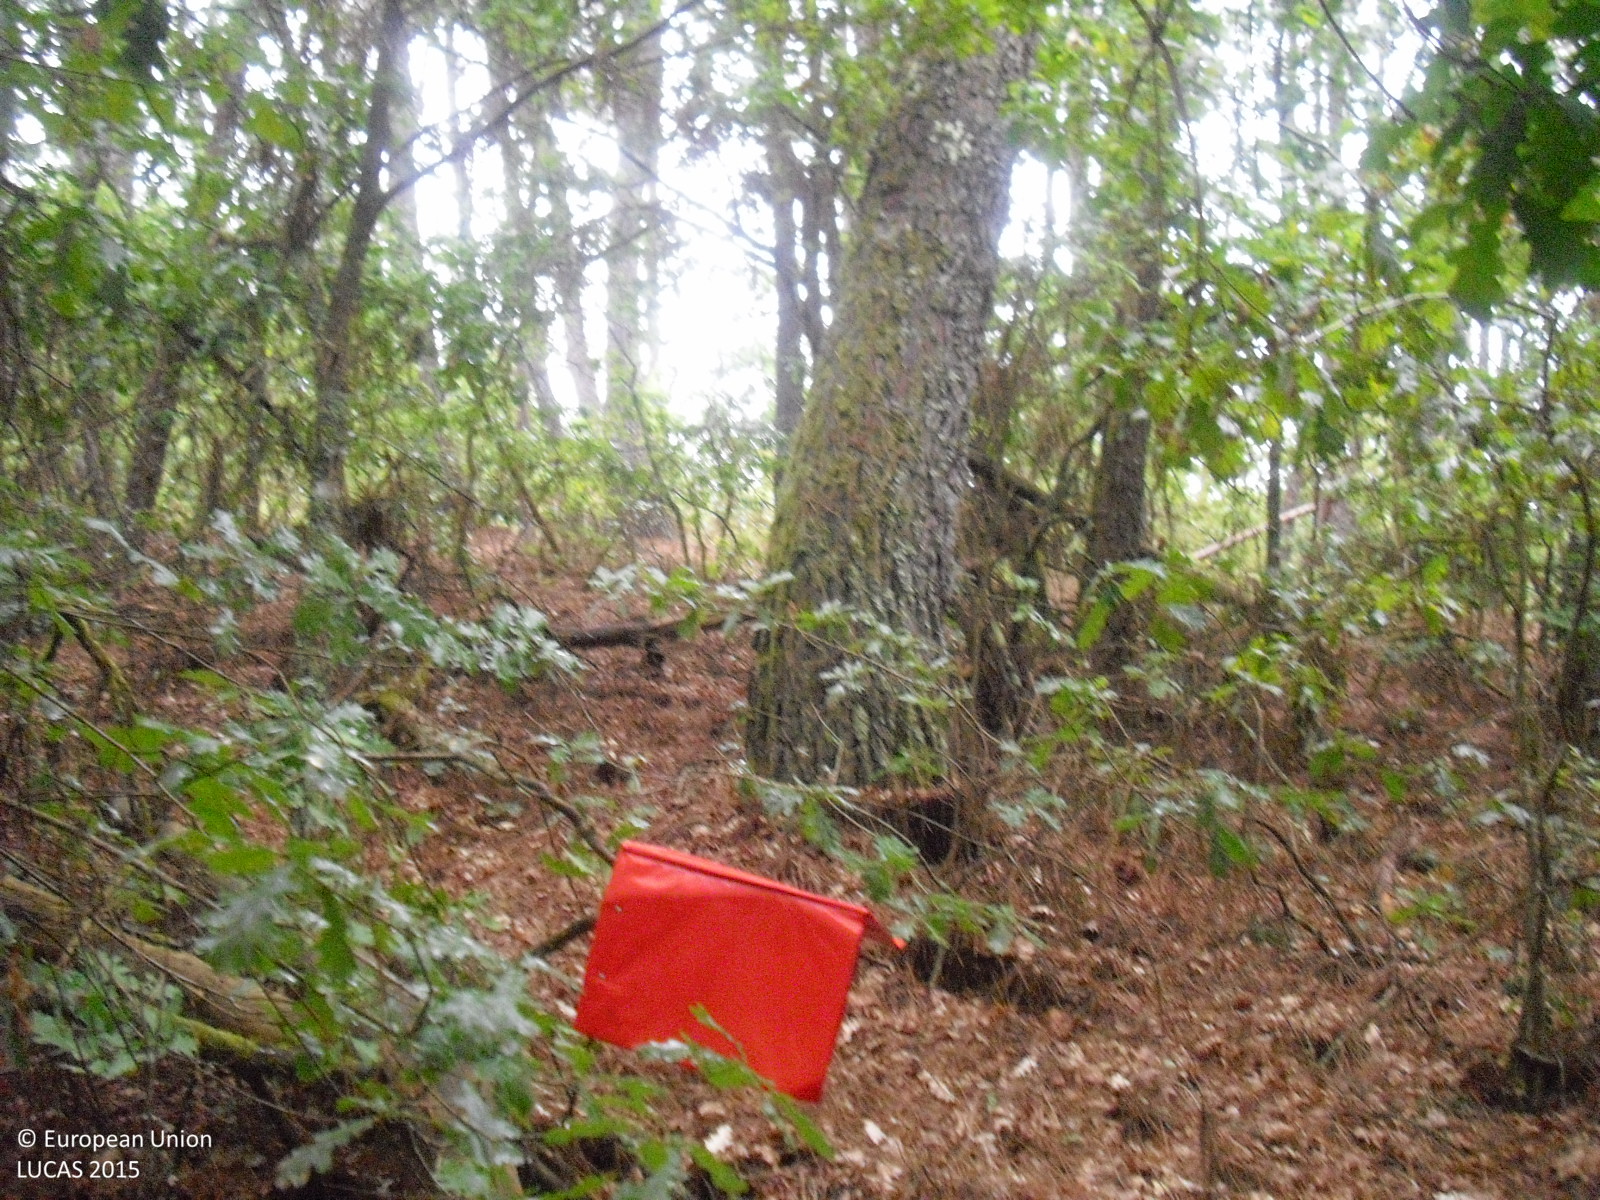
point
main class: Woodland
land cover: Pine dominated mixed woodland
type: hemiboreal forest and nemoral coniferous forest and mixed broadleaved-coniferous forest
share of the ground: > 75 %
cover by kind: coniferous forest trees 60 %, broadleaved forest trees 20 %, shrubs 20 %
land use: Forestry
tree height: > 5 m
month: July
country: ES
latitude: 42.3026
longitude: -7.6725
